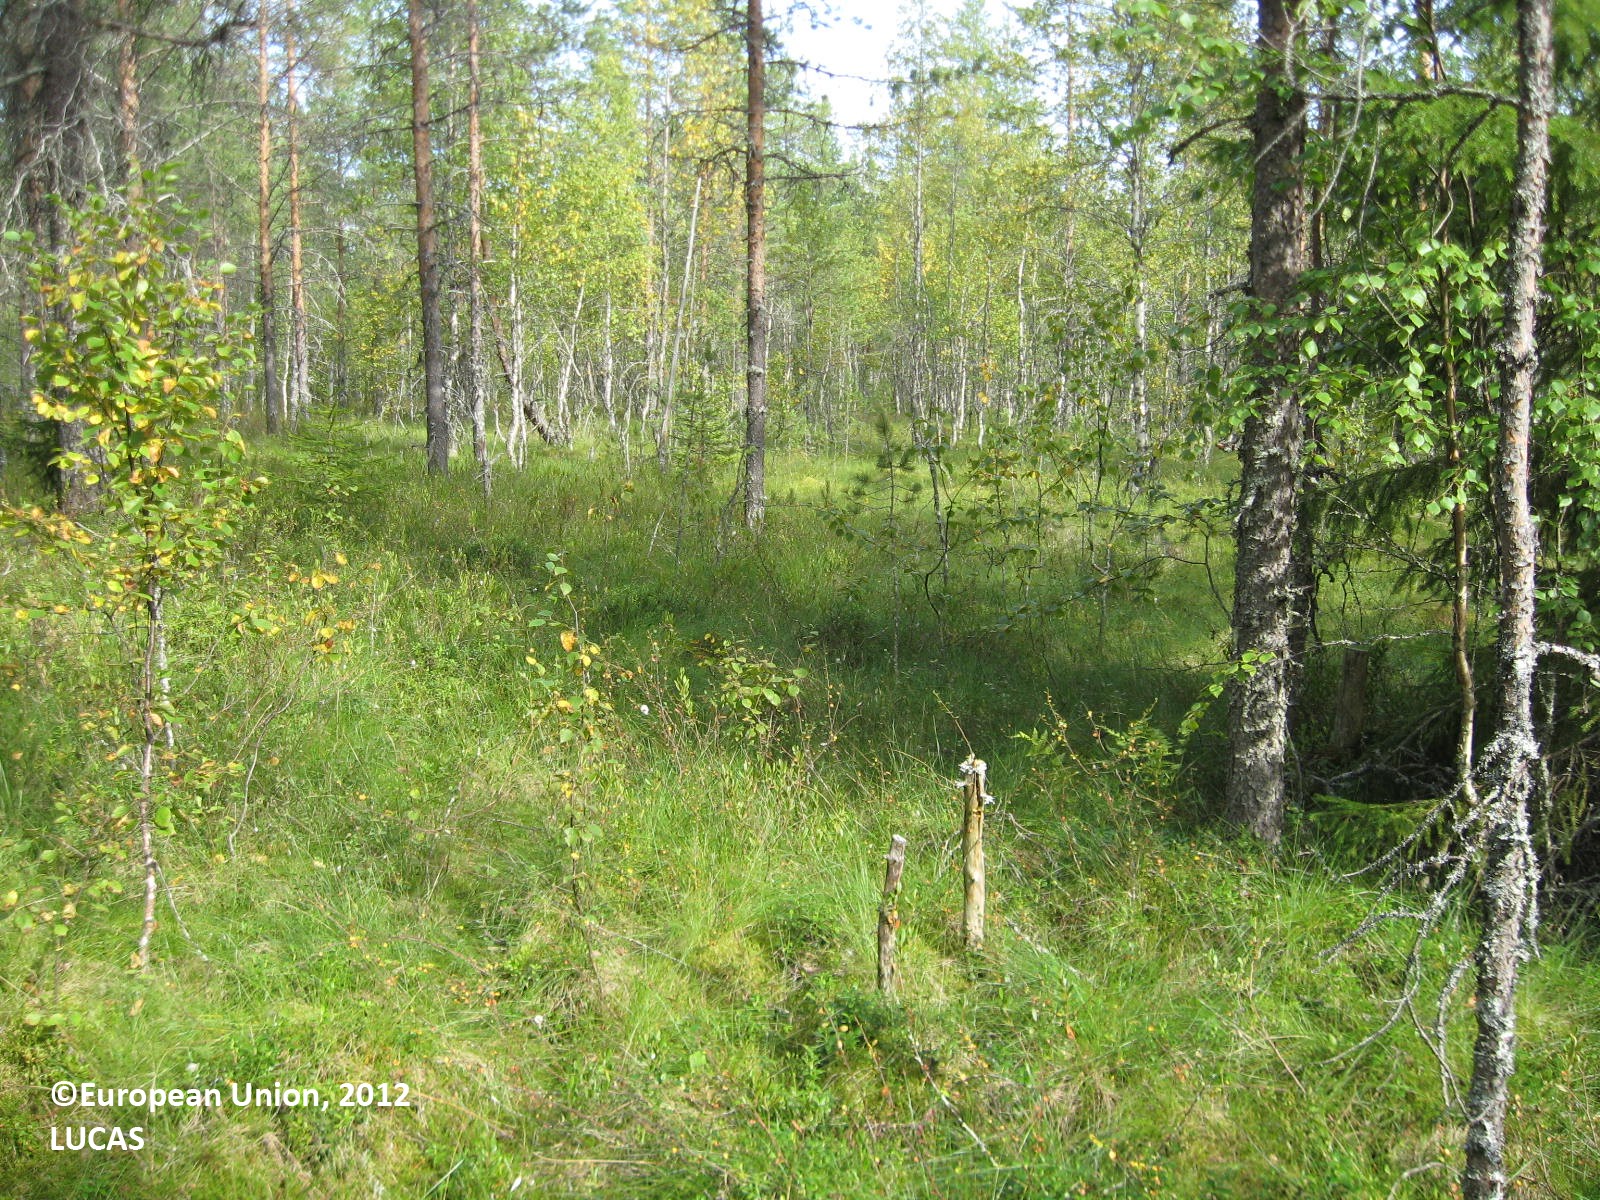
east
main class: Woodland
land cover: Pine dominated mixed woodland
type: boreal forest
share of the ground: 50 - 75 %
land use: Forestry
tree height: > 5 m
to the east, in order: Pine dominated mixed woodland; Pine dominated coniferous woodland; Ditches and canals; Pine dominated coniferous woodland
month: August
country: FI
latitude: 63.8425
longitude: 29.0525
